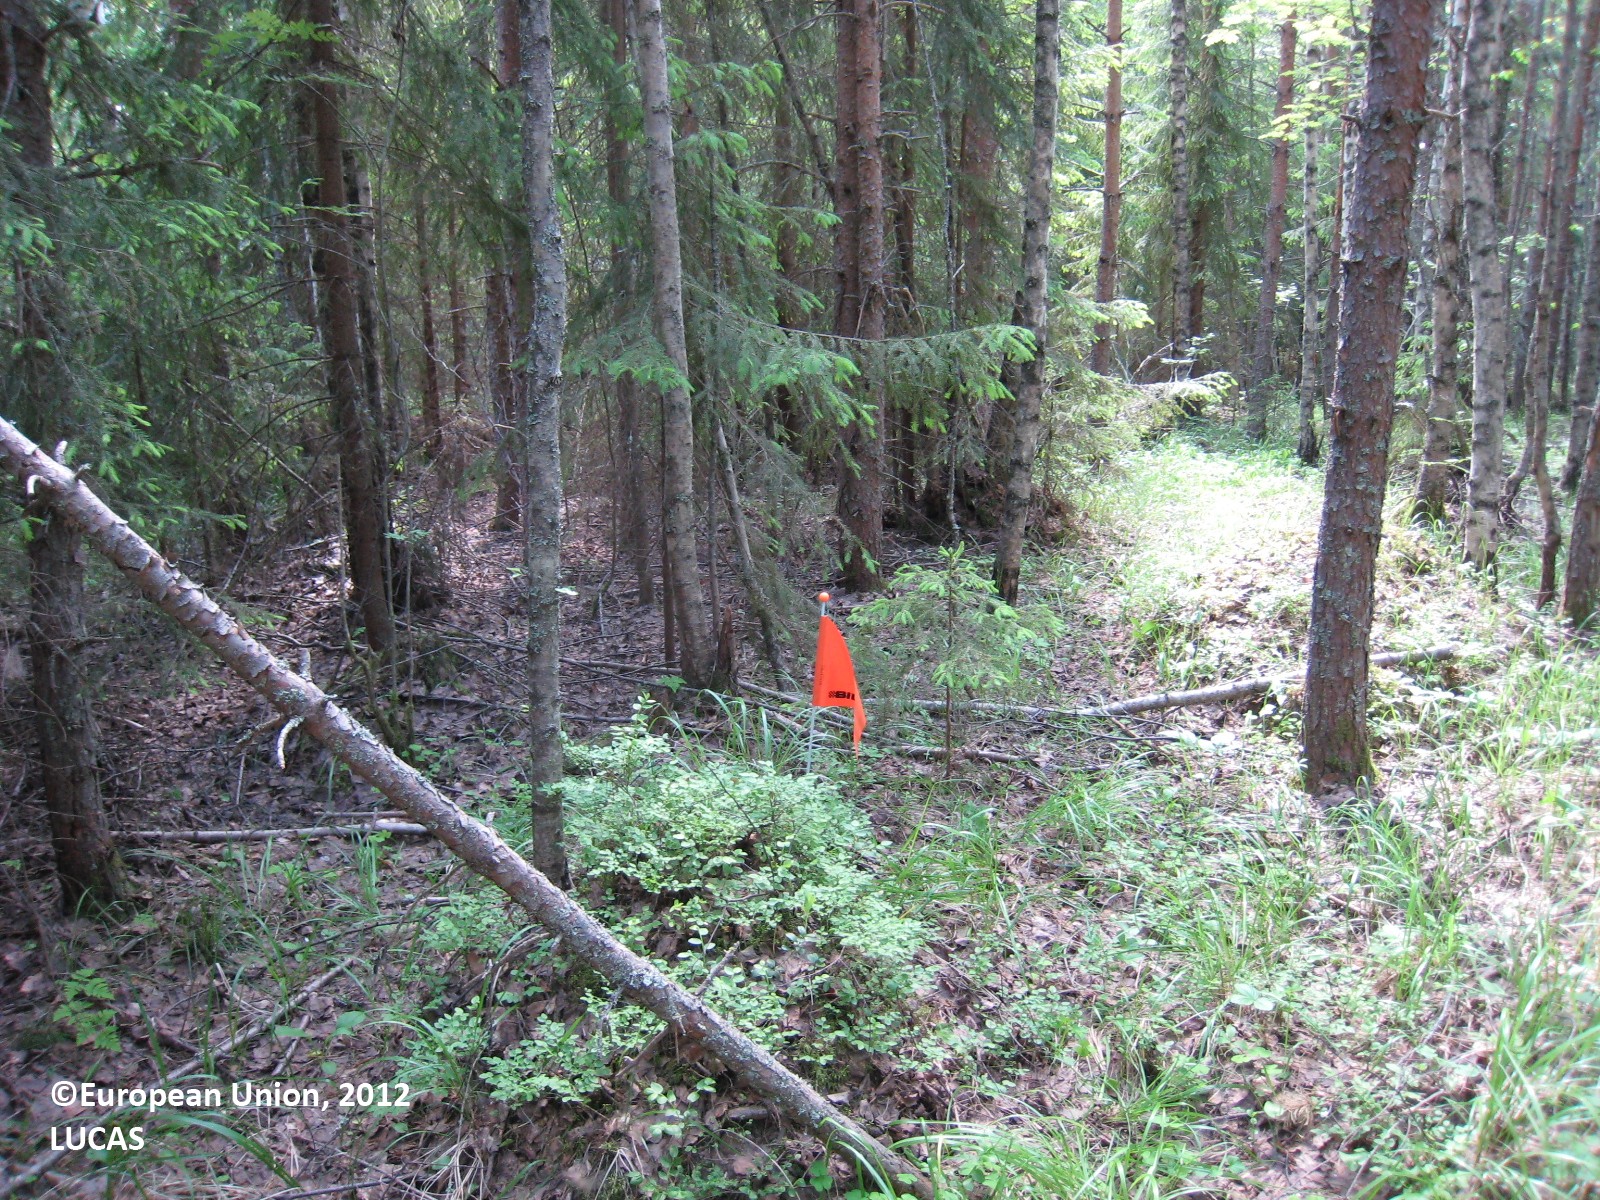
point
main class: Woodland
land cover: Other mixed woodland
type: boreal forest
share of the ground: > 75 %
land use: Forestry
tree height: > 5 m
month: June
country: FI
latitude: 62.0874
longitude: 25.7668
